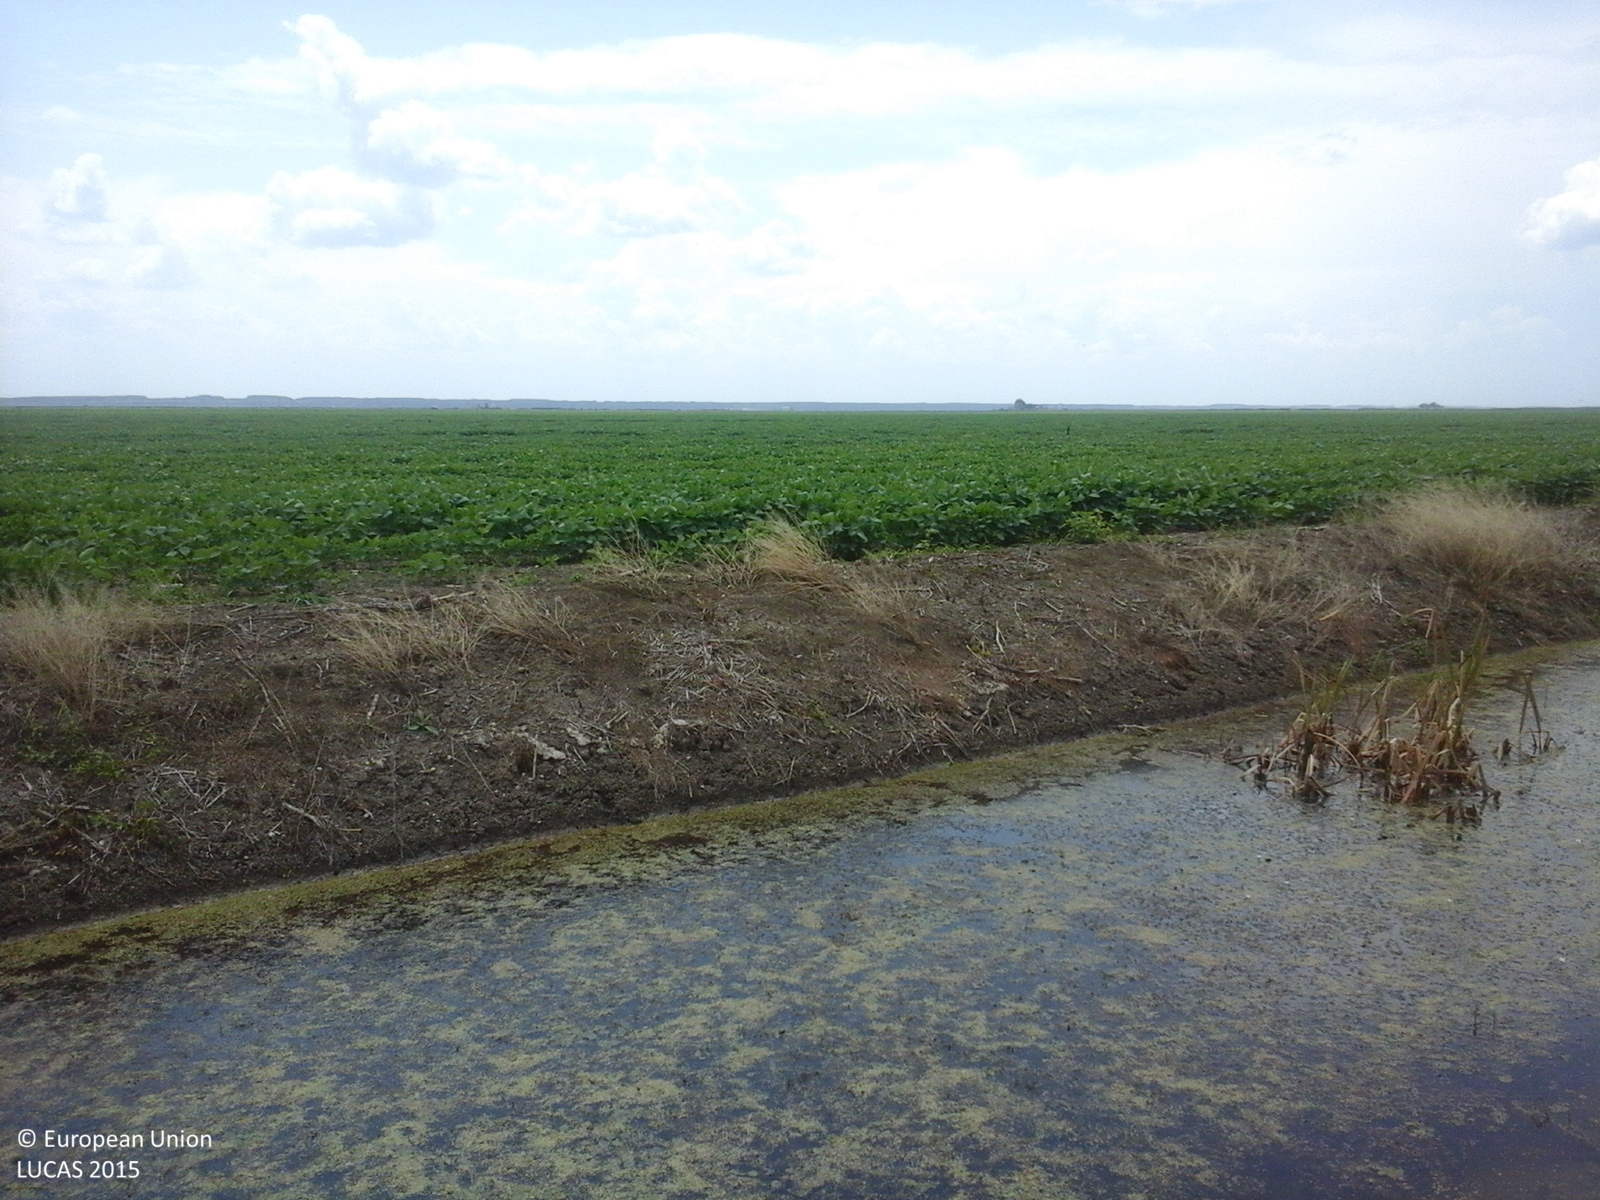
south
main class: Cropland
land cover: Soya
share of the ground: > 75 %
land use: Agriculture (excluding fallow land and kitchen gardens)
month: June
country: RO
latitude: 44.1029
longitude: 26.3863
